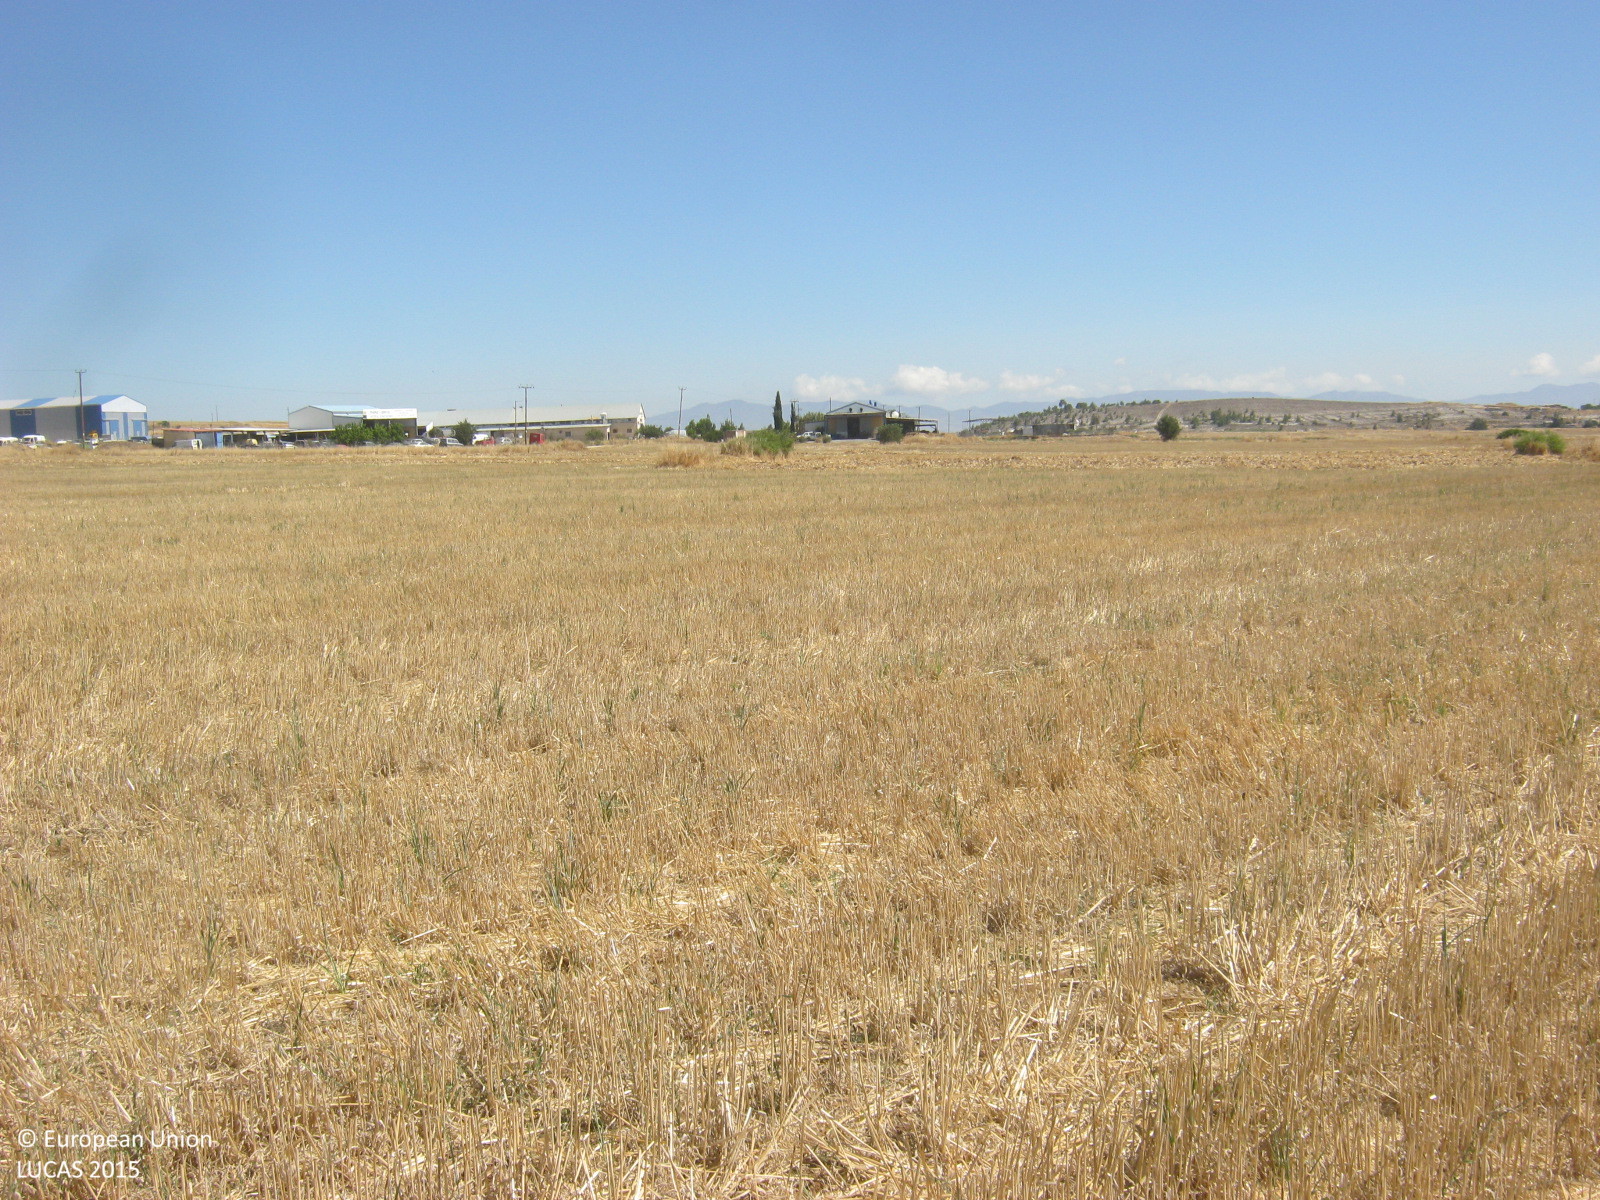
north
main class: Cropland
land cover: Barley
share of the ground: < 10 %
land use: Agriculture (excluding fallow land and kitchen gardens)
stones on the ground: < 10 %
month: June
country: CY
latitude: 35.0325
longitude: 33.1669
